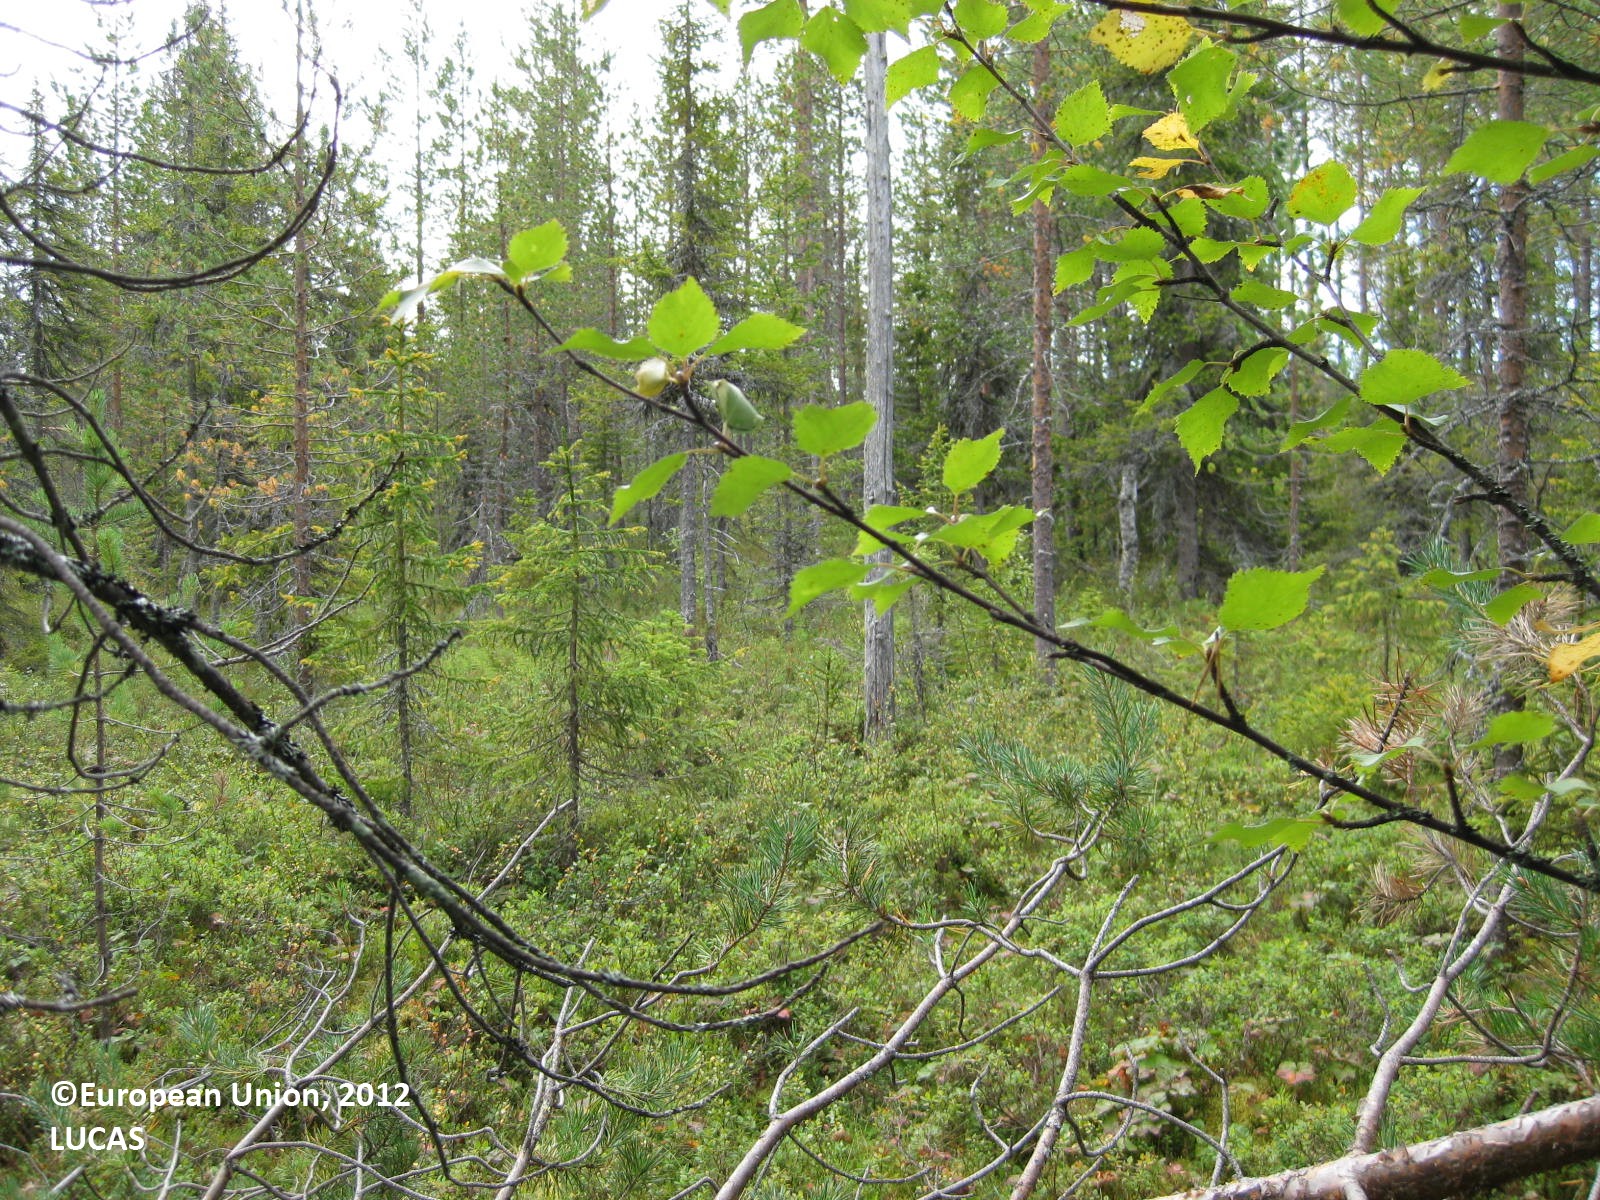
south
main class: Woodland
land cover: Pine dominated mixed woodland
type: boreal forest
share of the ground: > 75 %
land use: Forestry
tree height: > 5 m
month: August
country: FI
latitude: 66.2542
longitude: 28.7871
